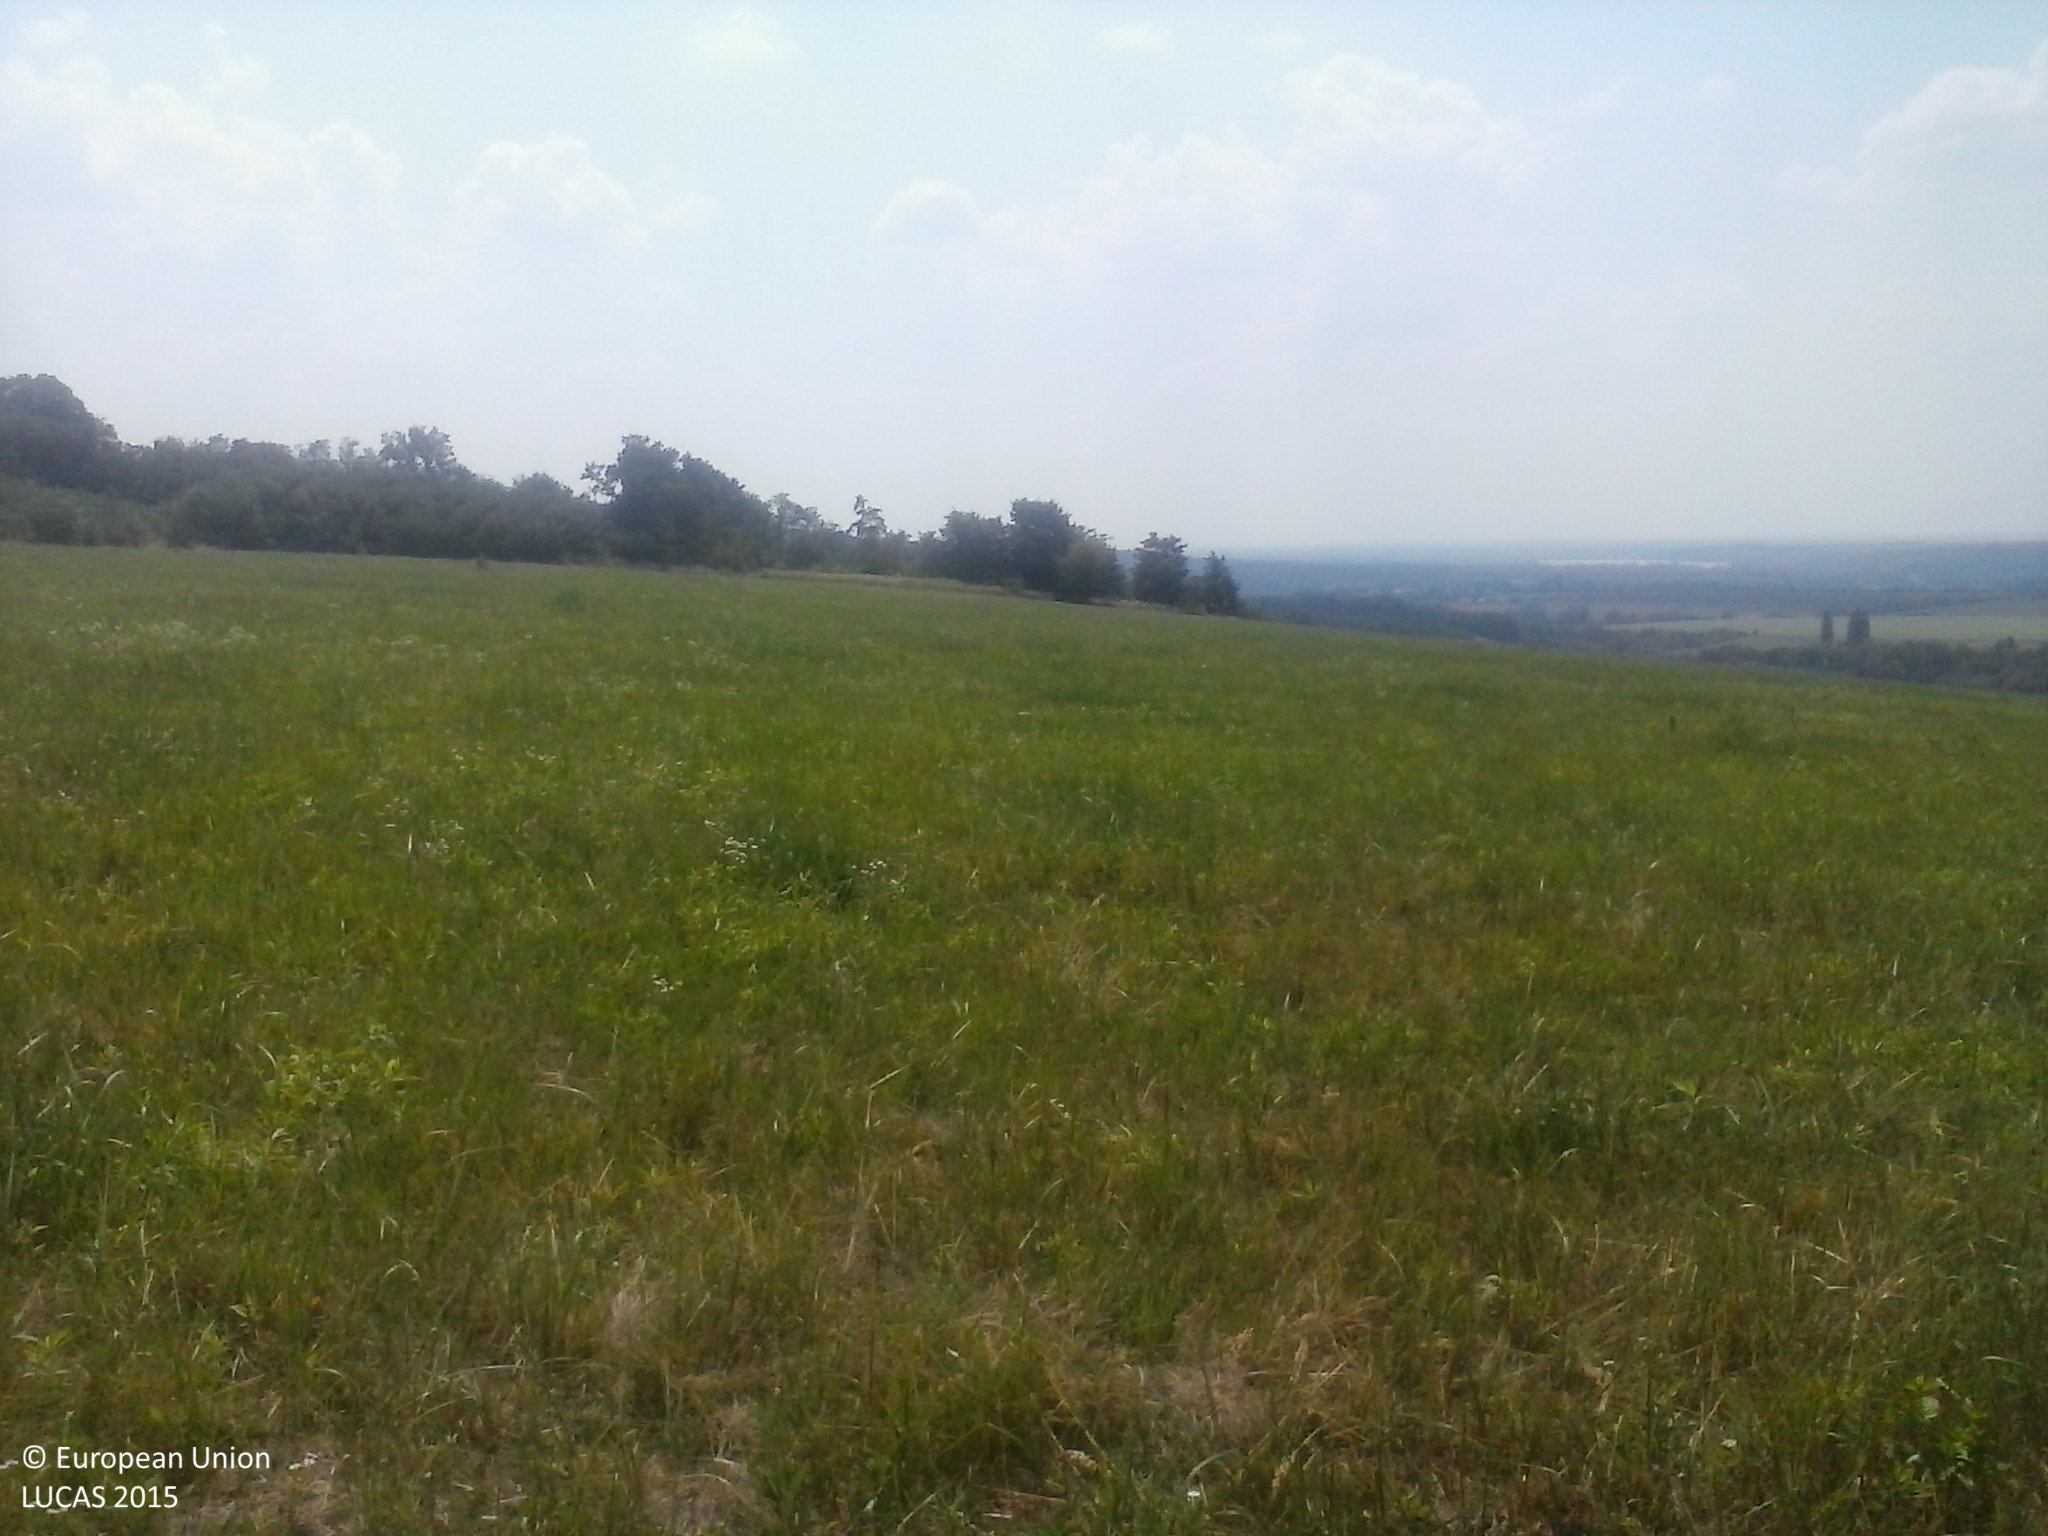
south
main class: Grassland
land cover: Grassland without tree/shrub cover
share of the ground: > 75 %
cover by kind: herbaceous plants 100 %
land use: Agriculture (excluding fallow land and kitchen gardens)
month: August
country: HU
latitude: 46.1339
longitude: 17.8622
